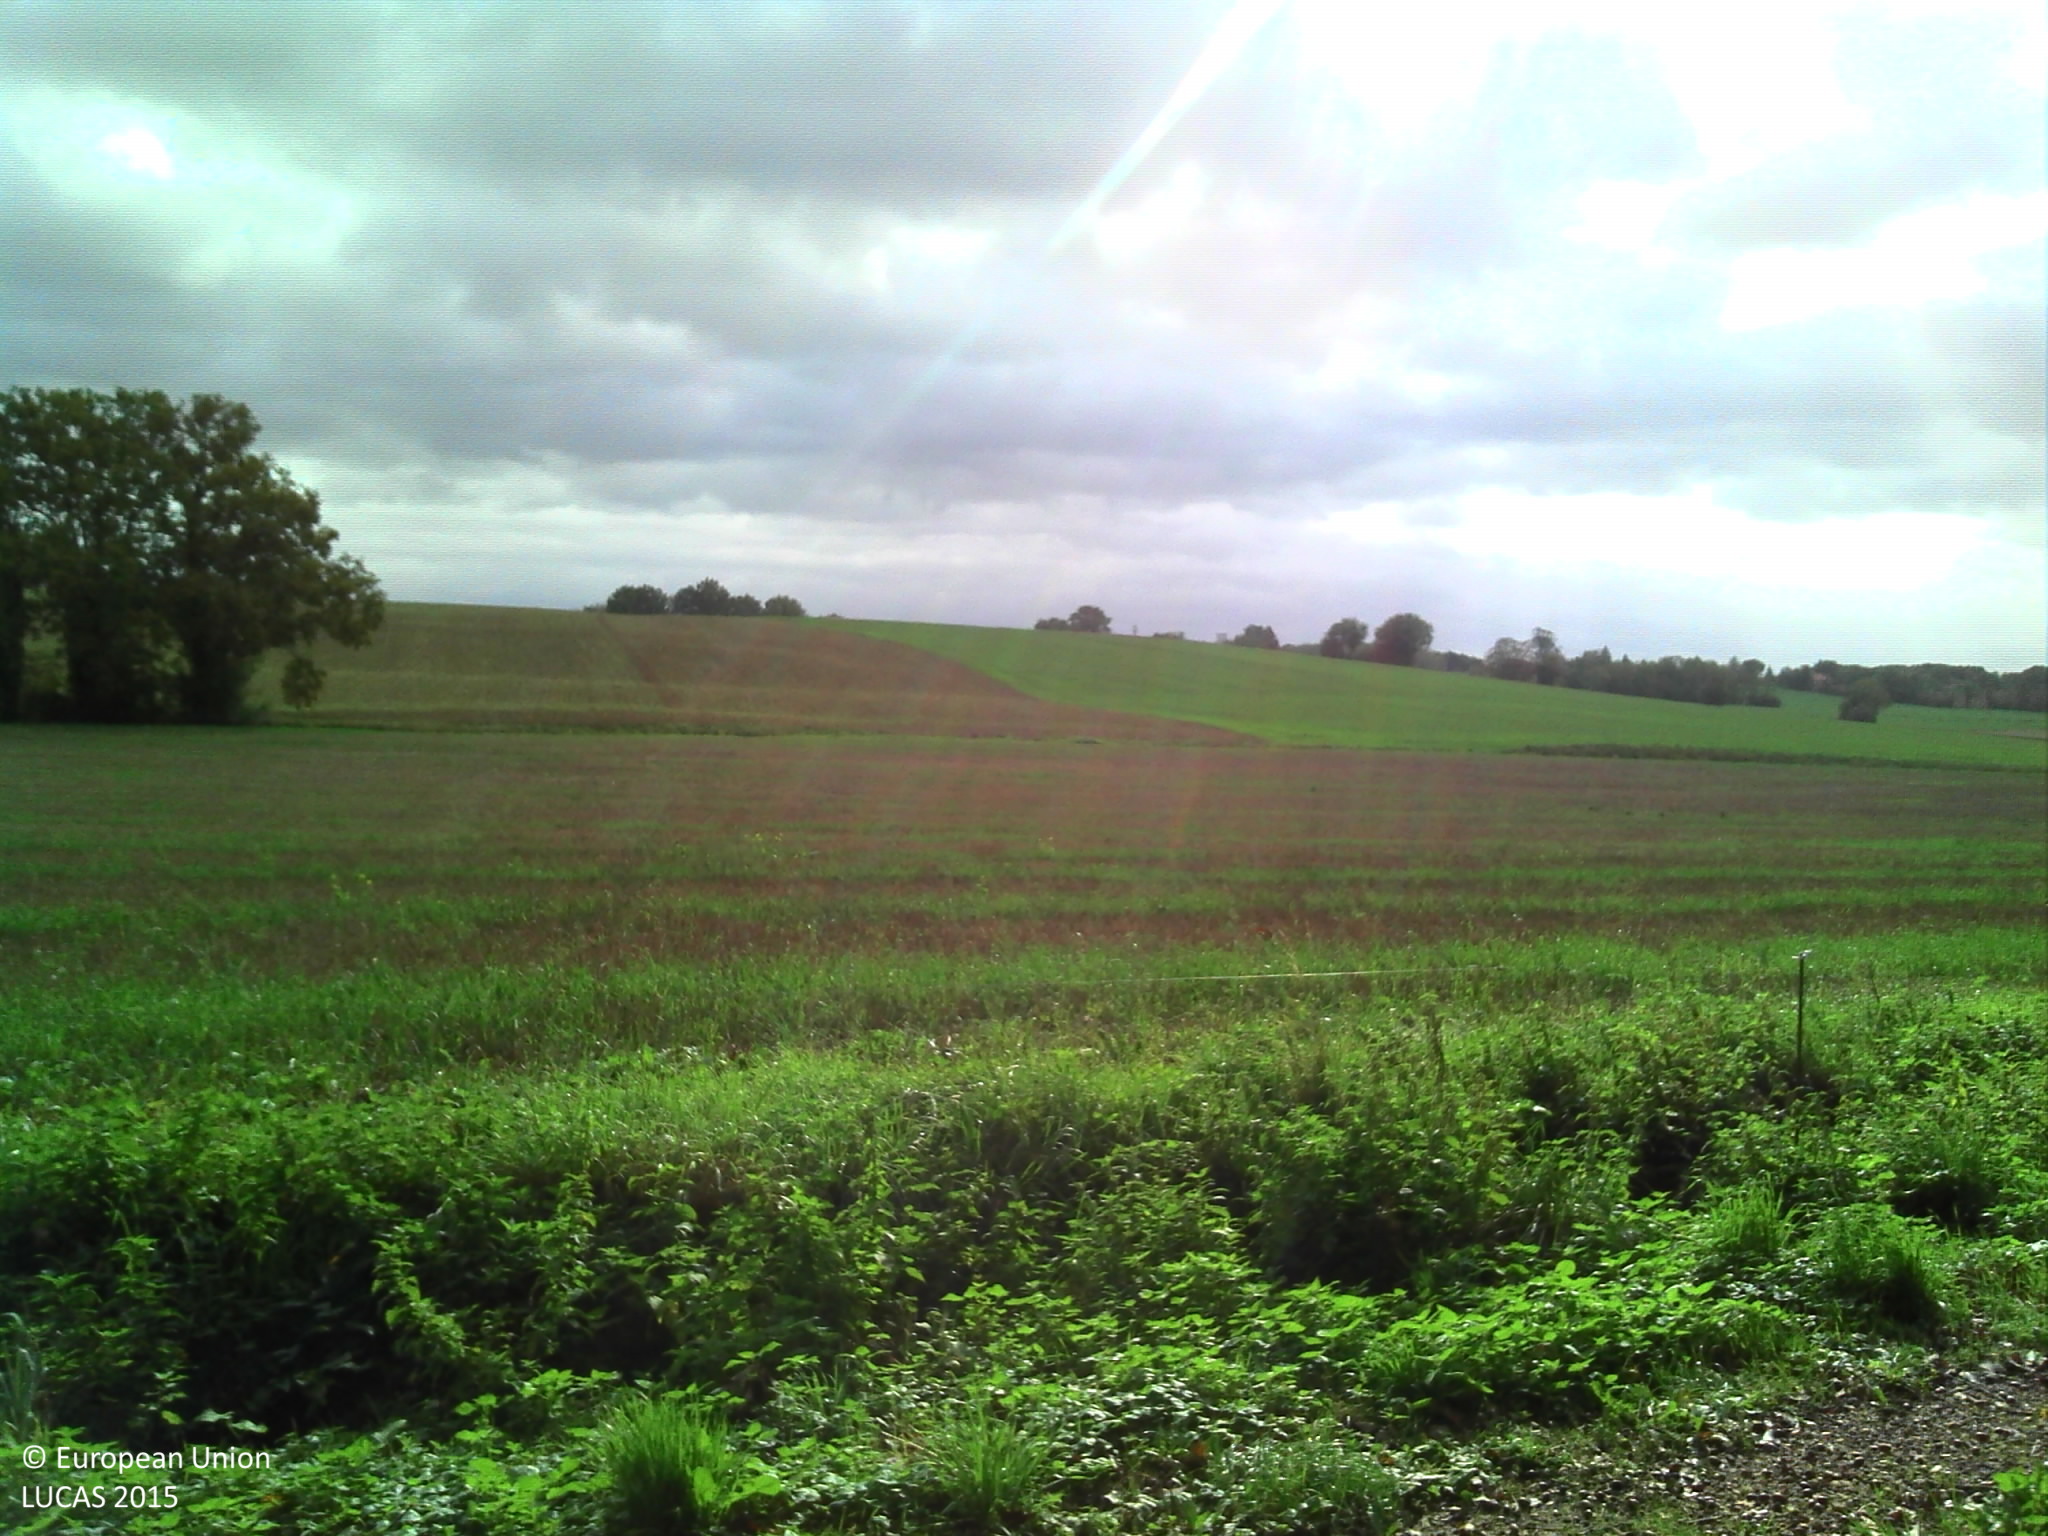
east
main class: Cropland
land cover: Common wheat
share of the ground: > 75 %
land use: Agriculture (excluding fallow land and kitchen gardens)
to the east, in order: Grass margins; Tracks; Grass margins; Ditches and canals; Electric lines; Fences; Common wheat; Grass margins; Fences; Ditches and canals; Grass margins; Broadleaved woodland; Barley
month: October
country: FR
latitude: 46.4540
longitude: 5.0680
